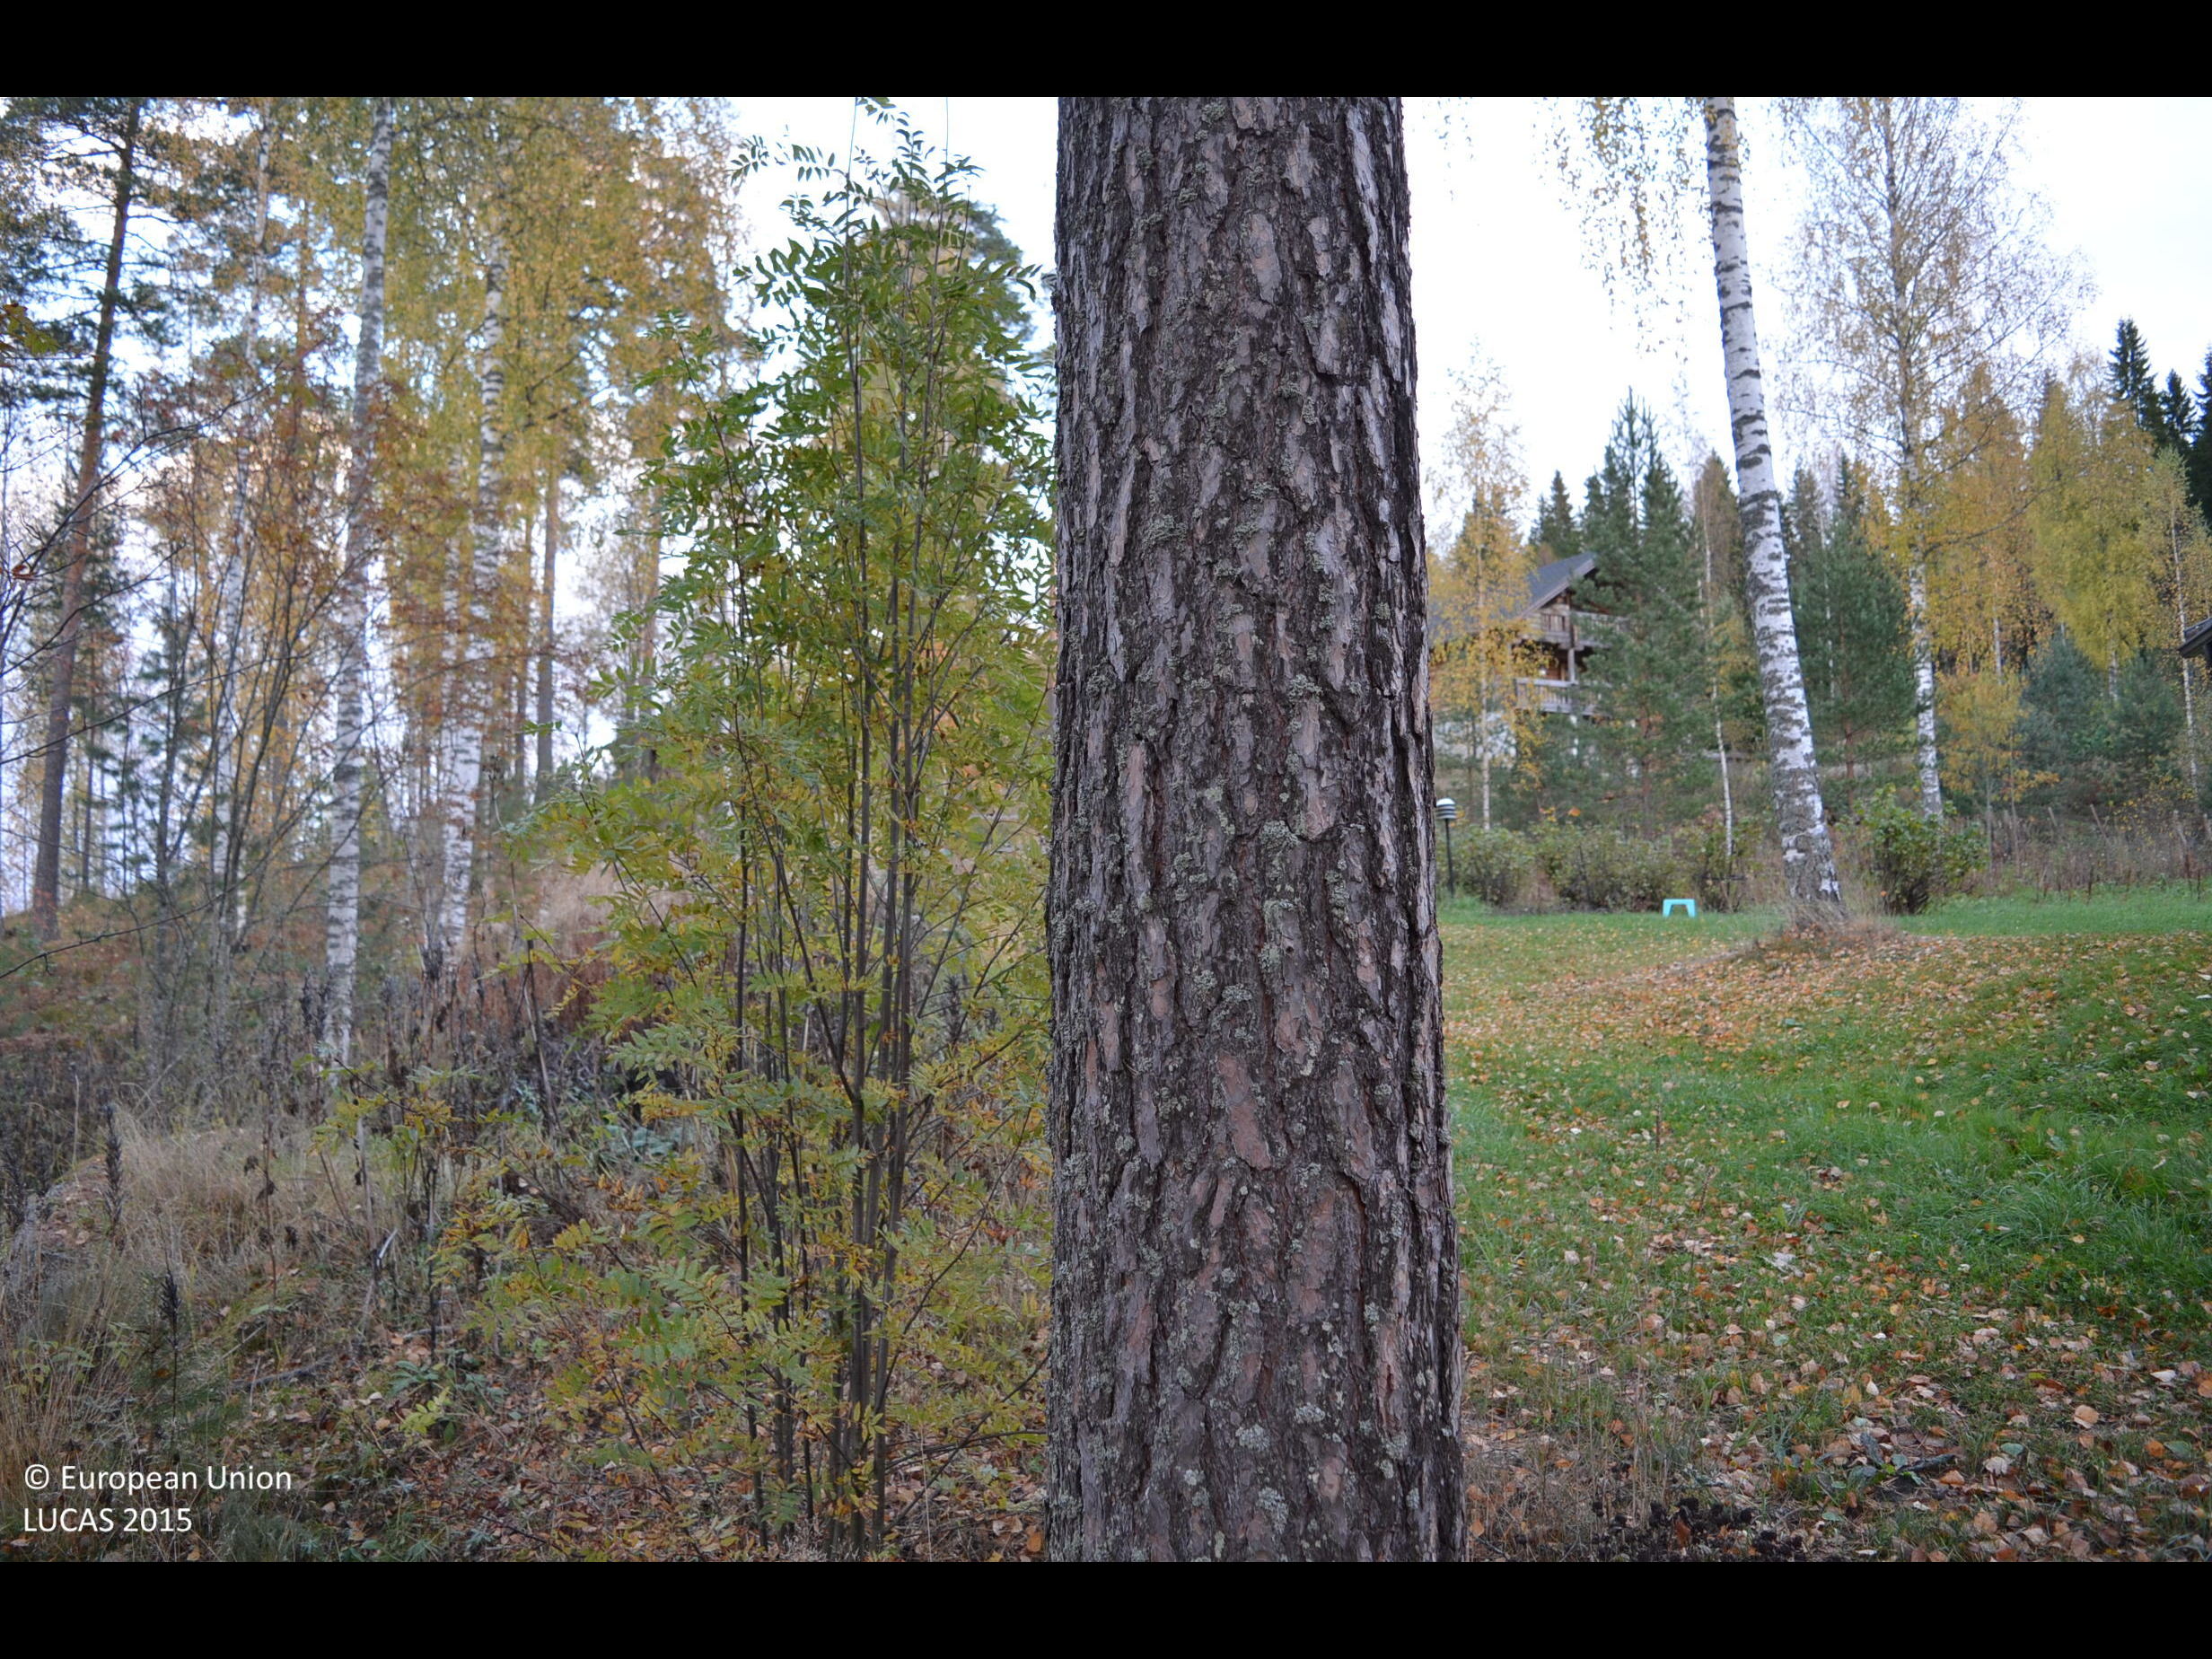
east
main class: Woodland
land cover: Other mixed woodland
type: boreal forest
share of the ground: 50 - 75 %
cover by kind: herbaceous plants 40 %, coniferous forest trees 25 %, broadleaved forest trees 25 %, shrubs 10 %
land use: Residential
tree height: > 5 m
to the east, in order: Other mixed woodland; Fences; Other mixed woodland; Spruce dominated coniferous woodland
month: October
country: FI
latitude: 61.6351
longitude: 23.8781
